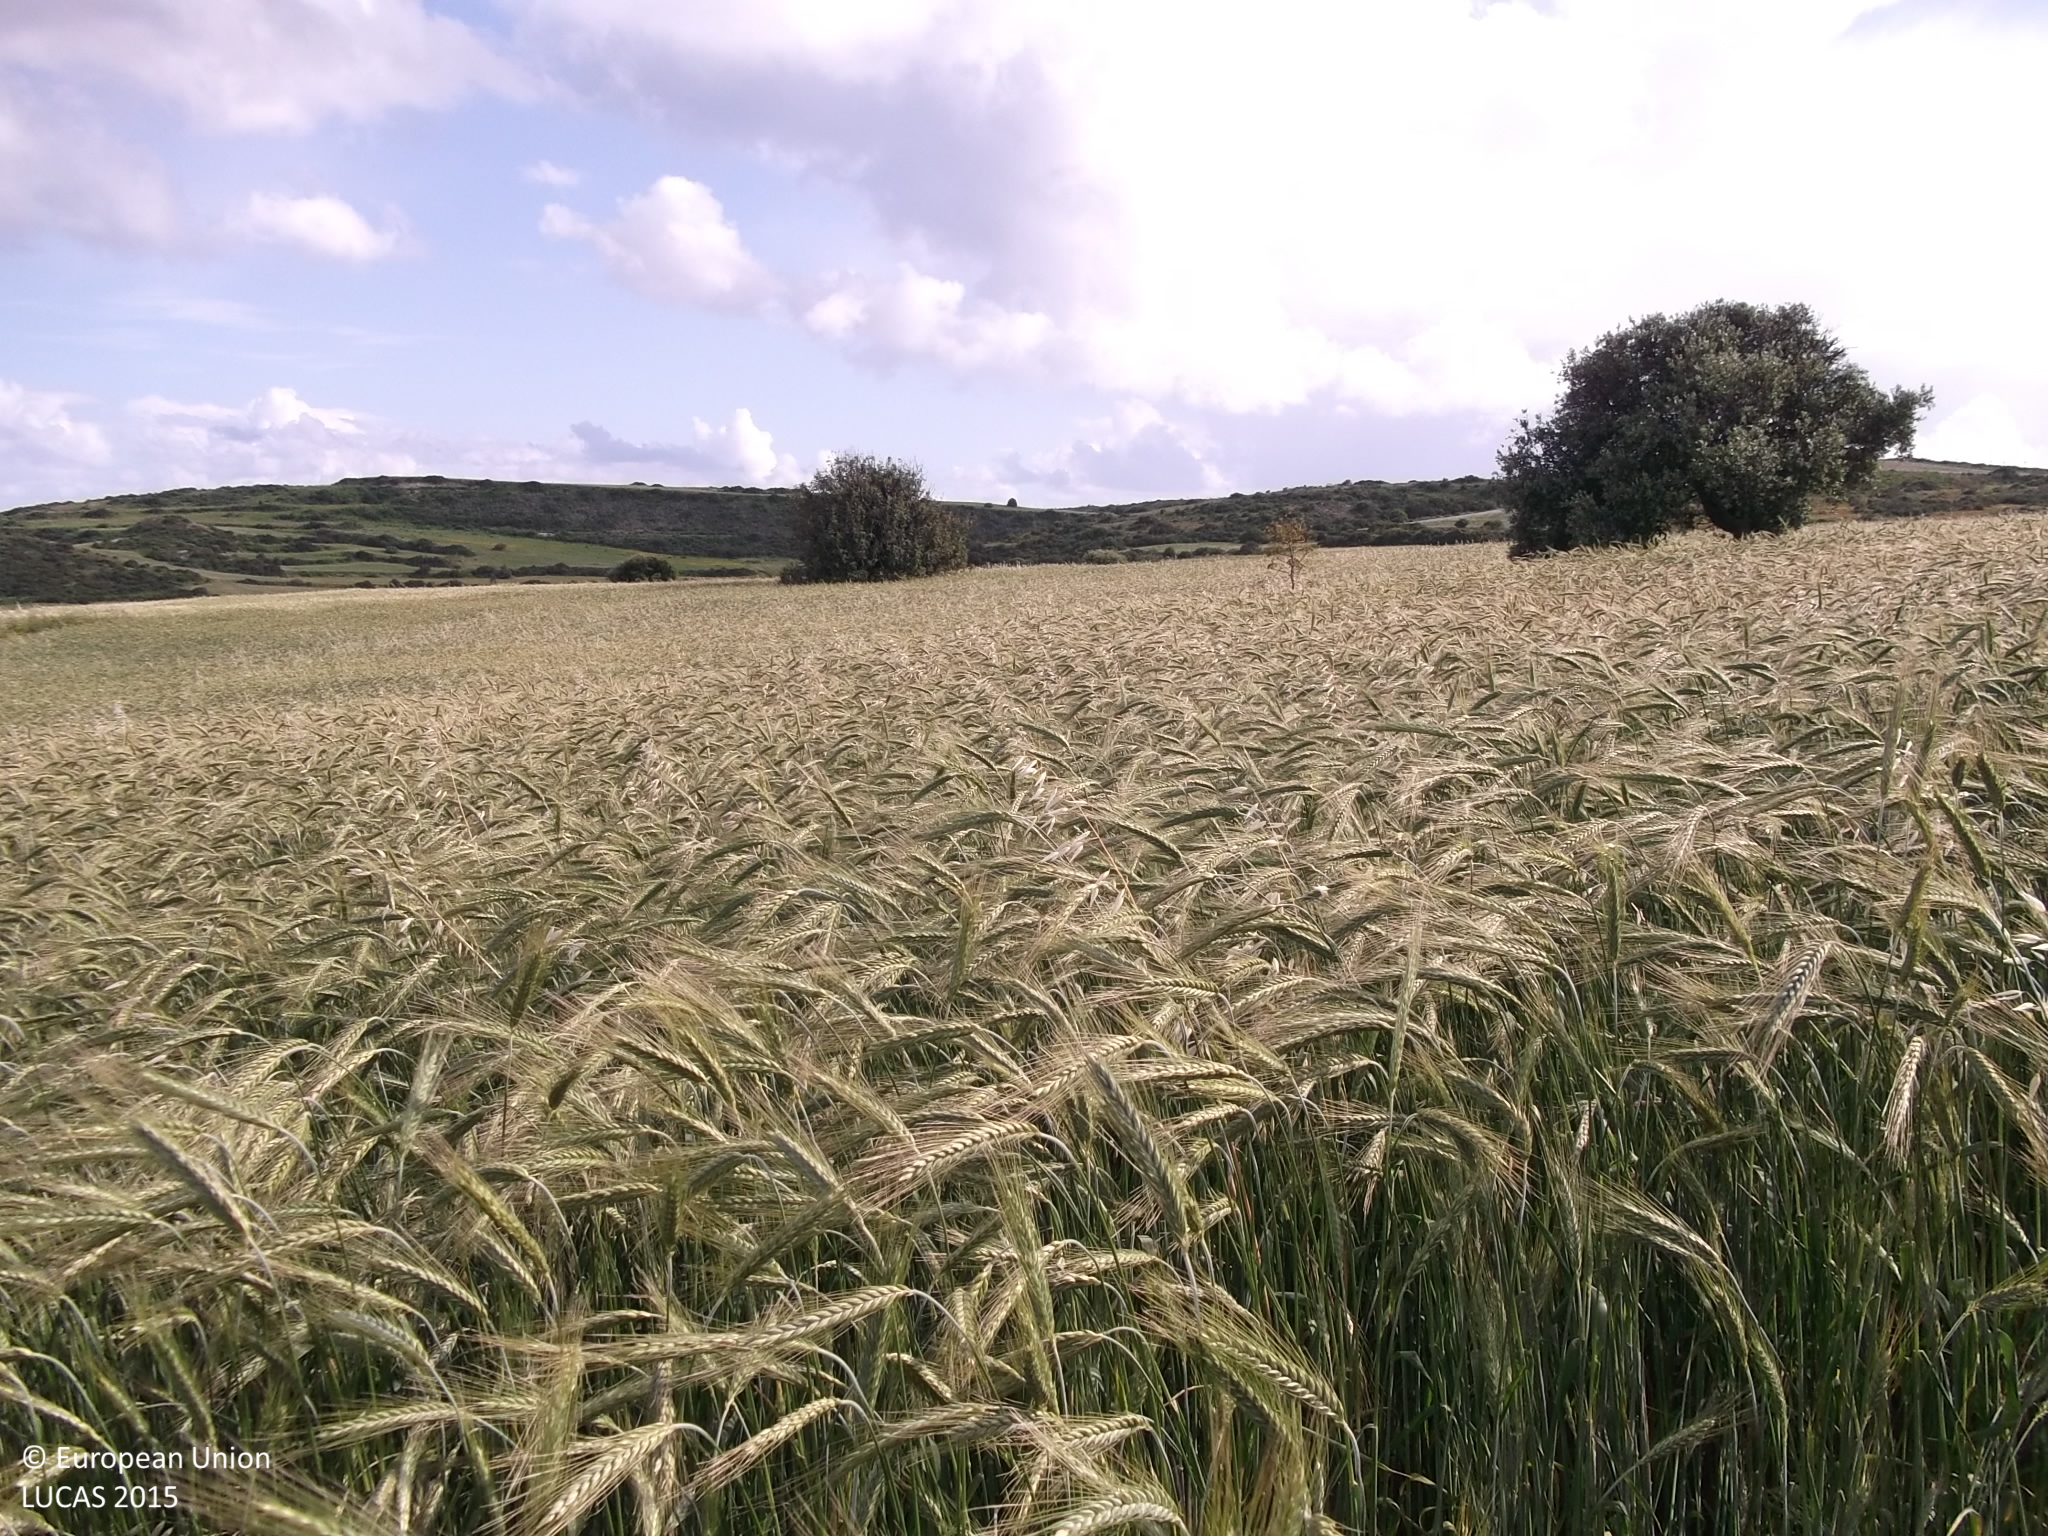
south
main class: Shrubland
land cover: Shrubland without tree cover
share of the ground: 50 - 75 %
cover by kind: shrubs 70 %, herbaceous plants 20 %, unconsolidated bare surface 10 %
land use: Semi-natural and natural areas not in use
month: April
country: CY
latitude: 34.7952
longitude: 33.4313
